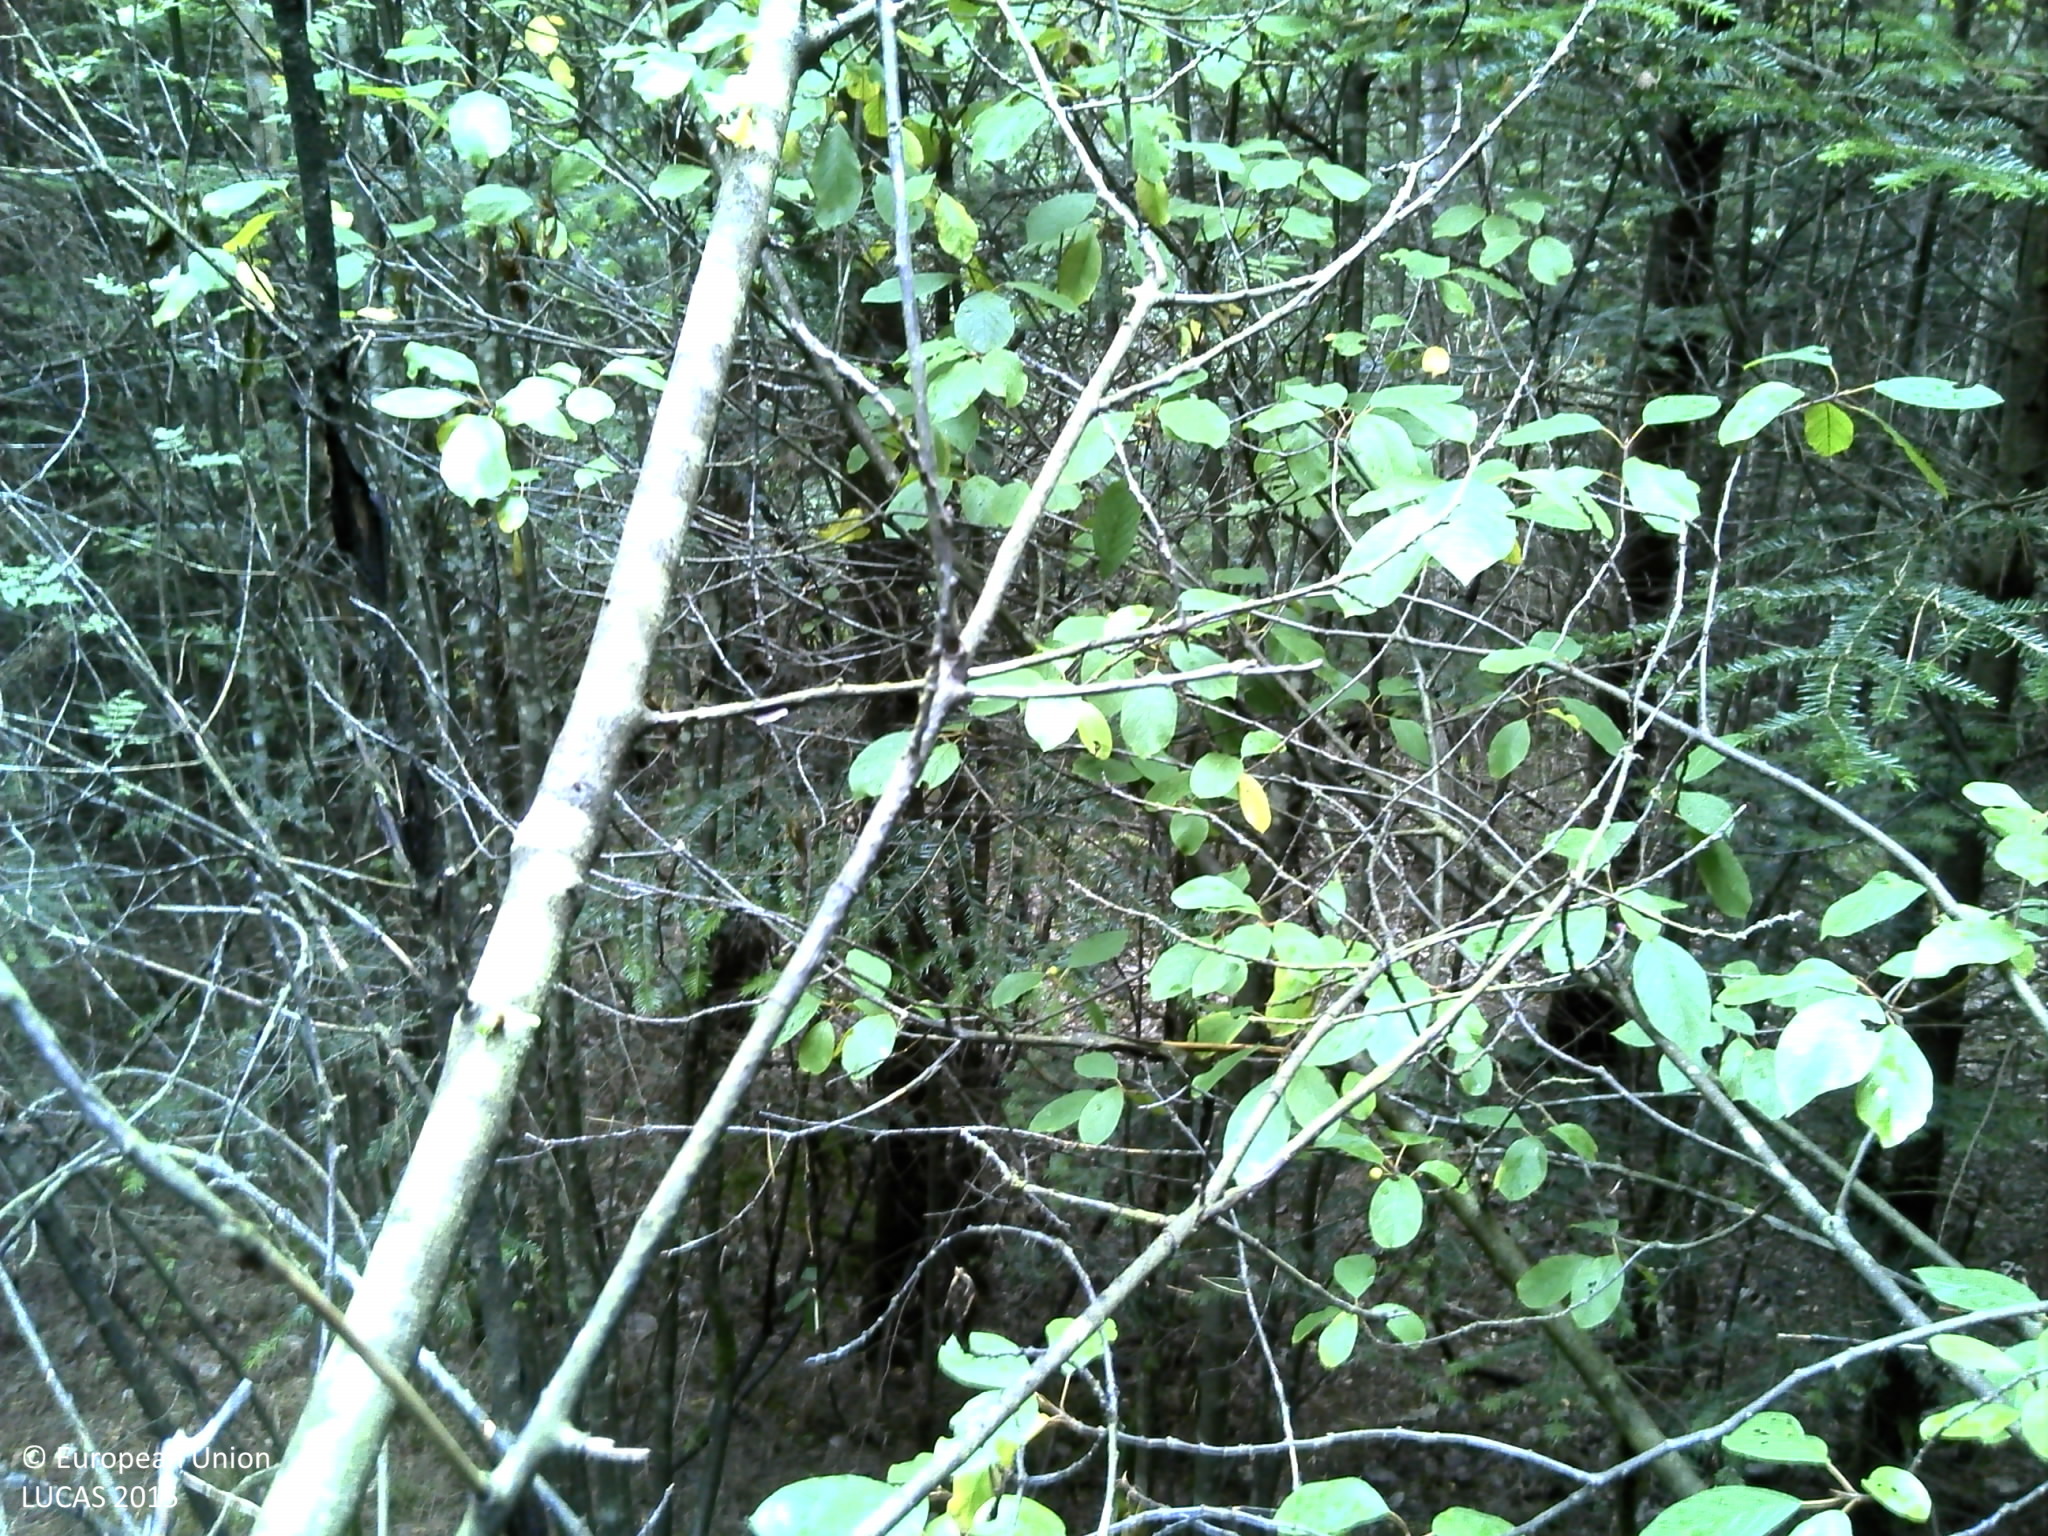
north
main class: Woodland
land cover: Spruce dominated mixed woodland
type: hemiboreal forest and nemoral coniferous forest and mixed broadleaved-coniferous forest
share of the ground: > 75 %
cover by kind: coniferous forest trees 60 %, broadleaved forest trees 35 %, herbaceous plants 5 %
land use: Forestry
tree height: > 5 m
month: August
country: FR
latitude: 48.3041
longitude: 6.8326
